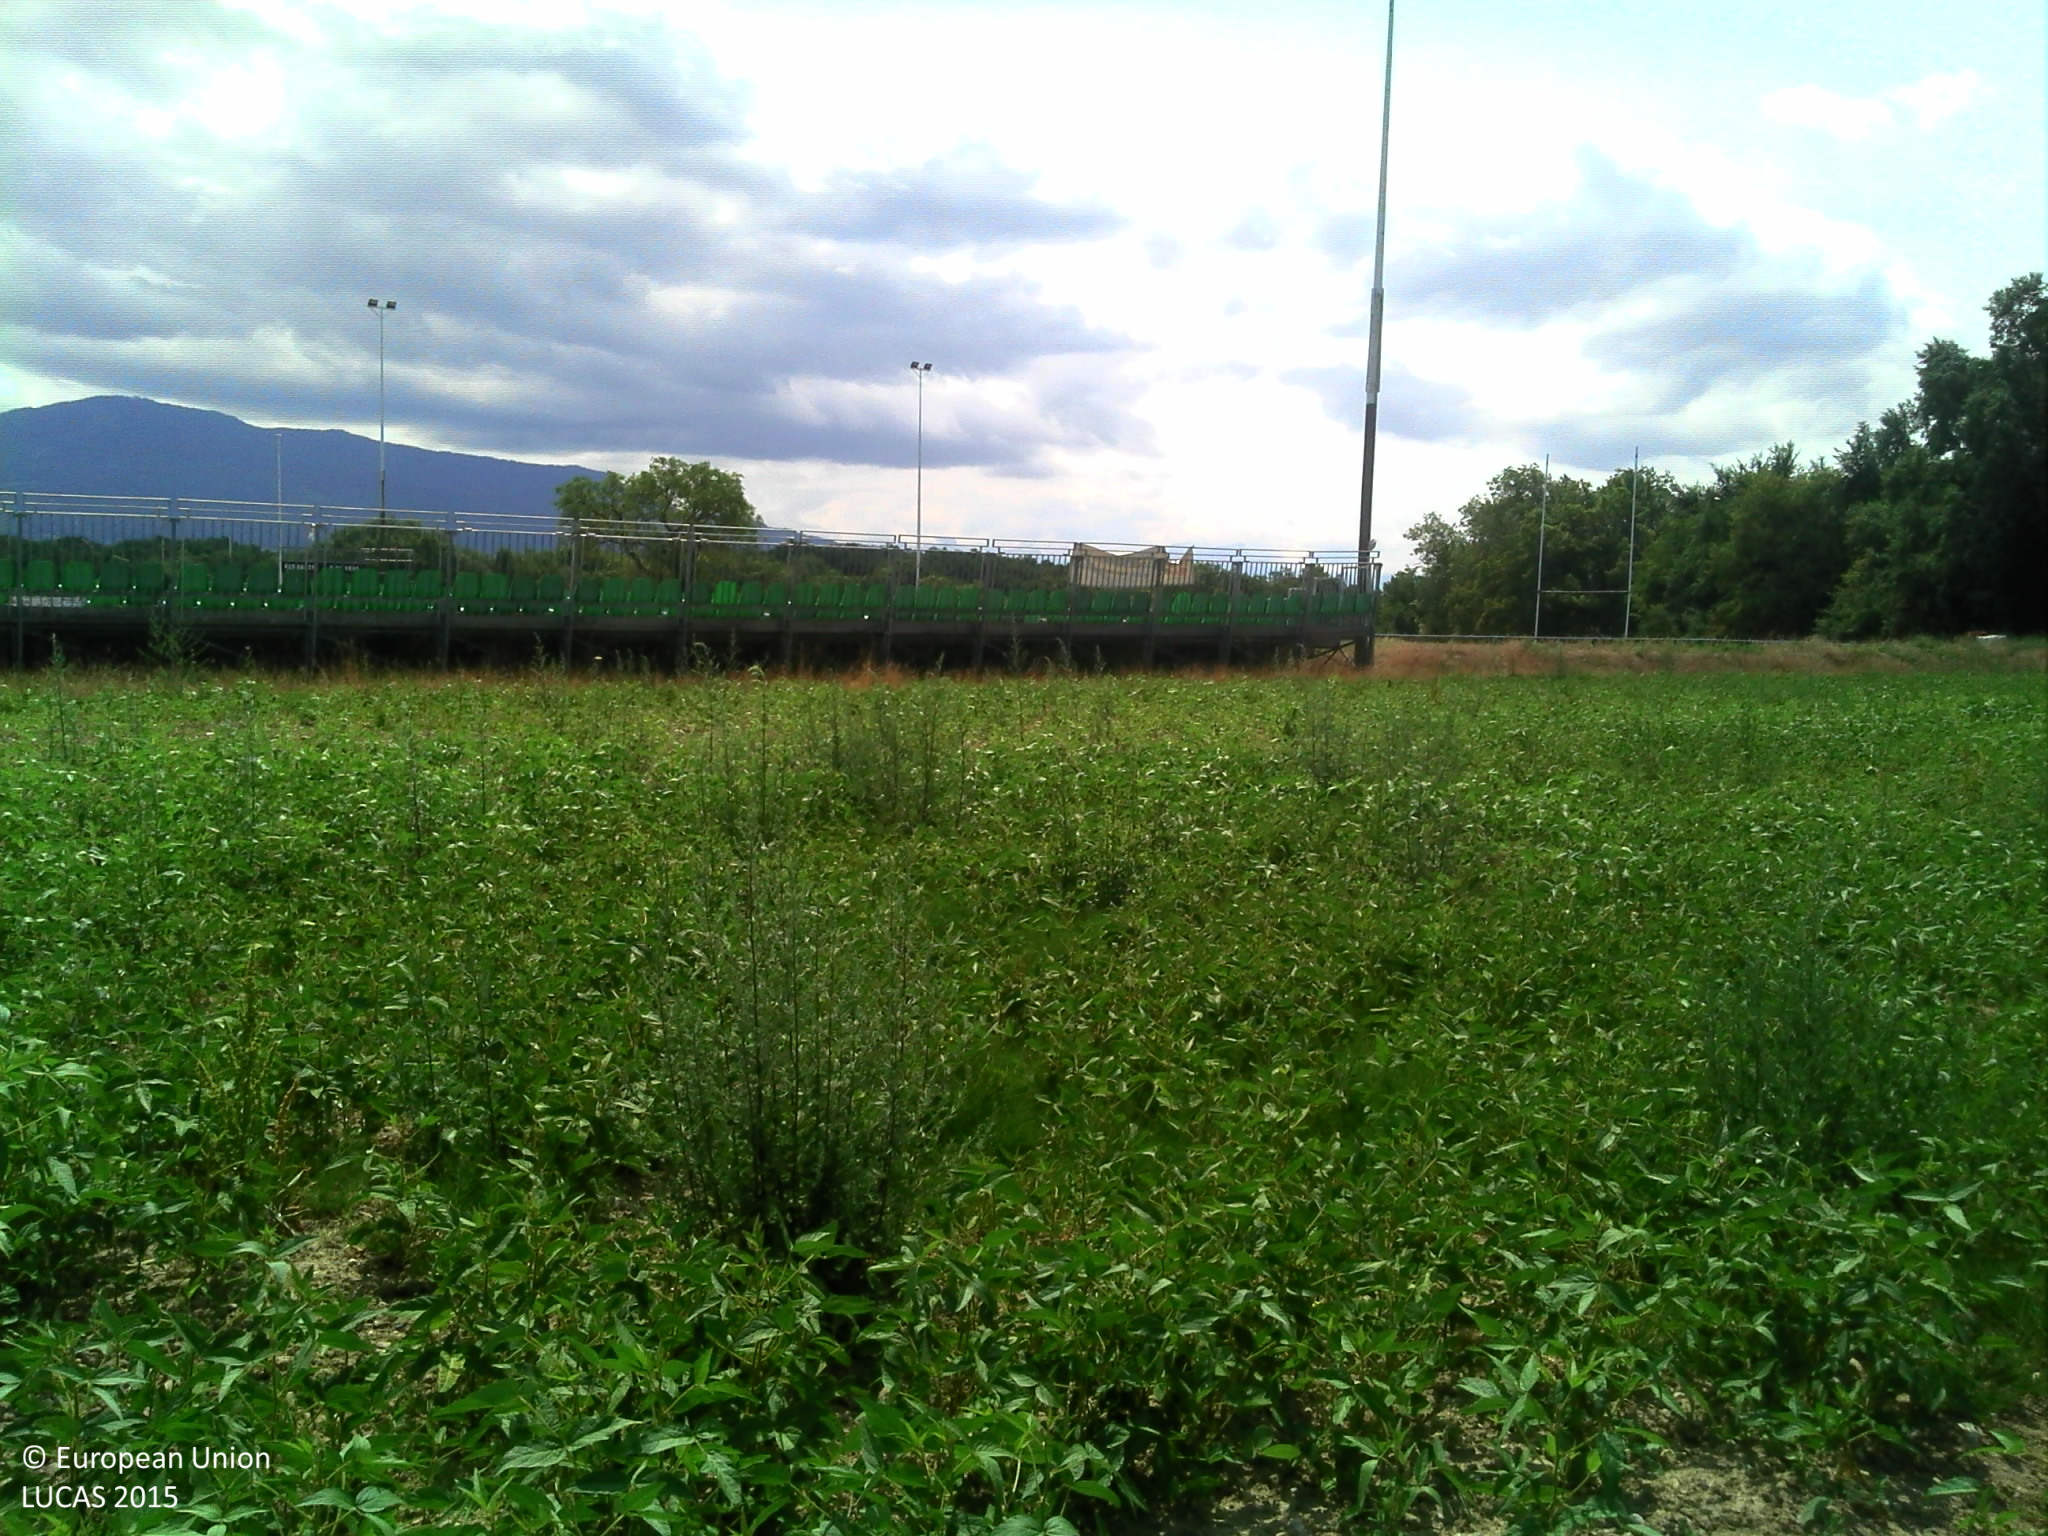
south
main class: Cropland
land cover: Soya
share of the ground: > 75 %
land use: Agriculture (excluding fallow land and kitchen gardens)
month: July
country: FR
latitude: 46.3036
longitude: 6.2510
